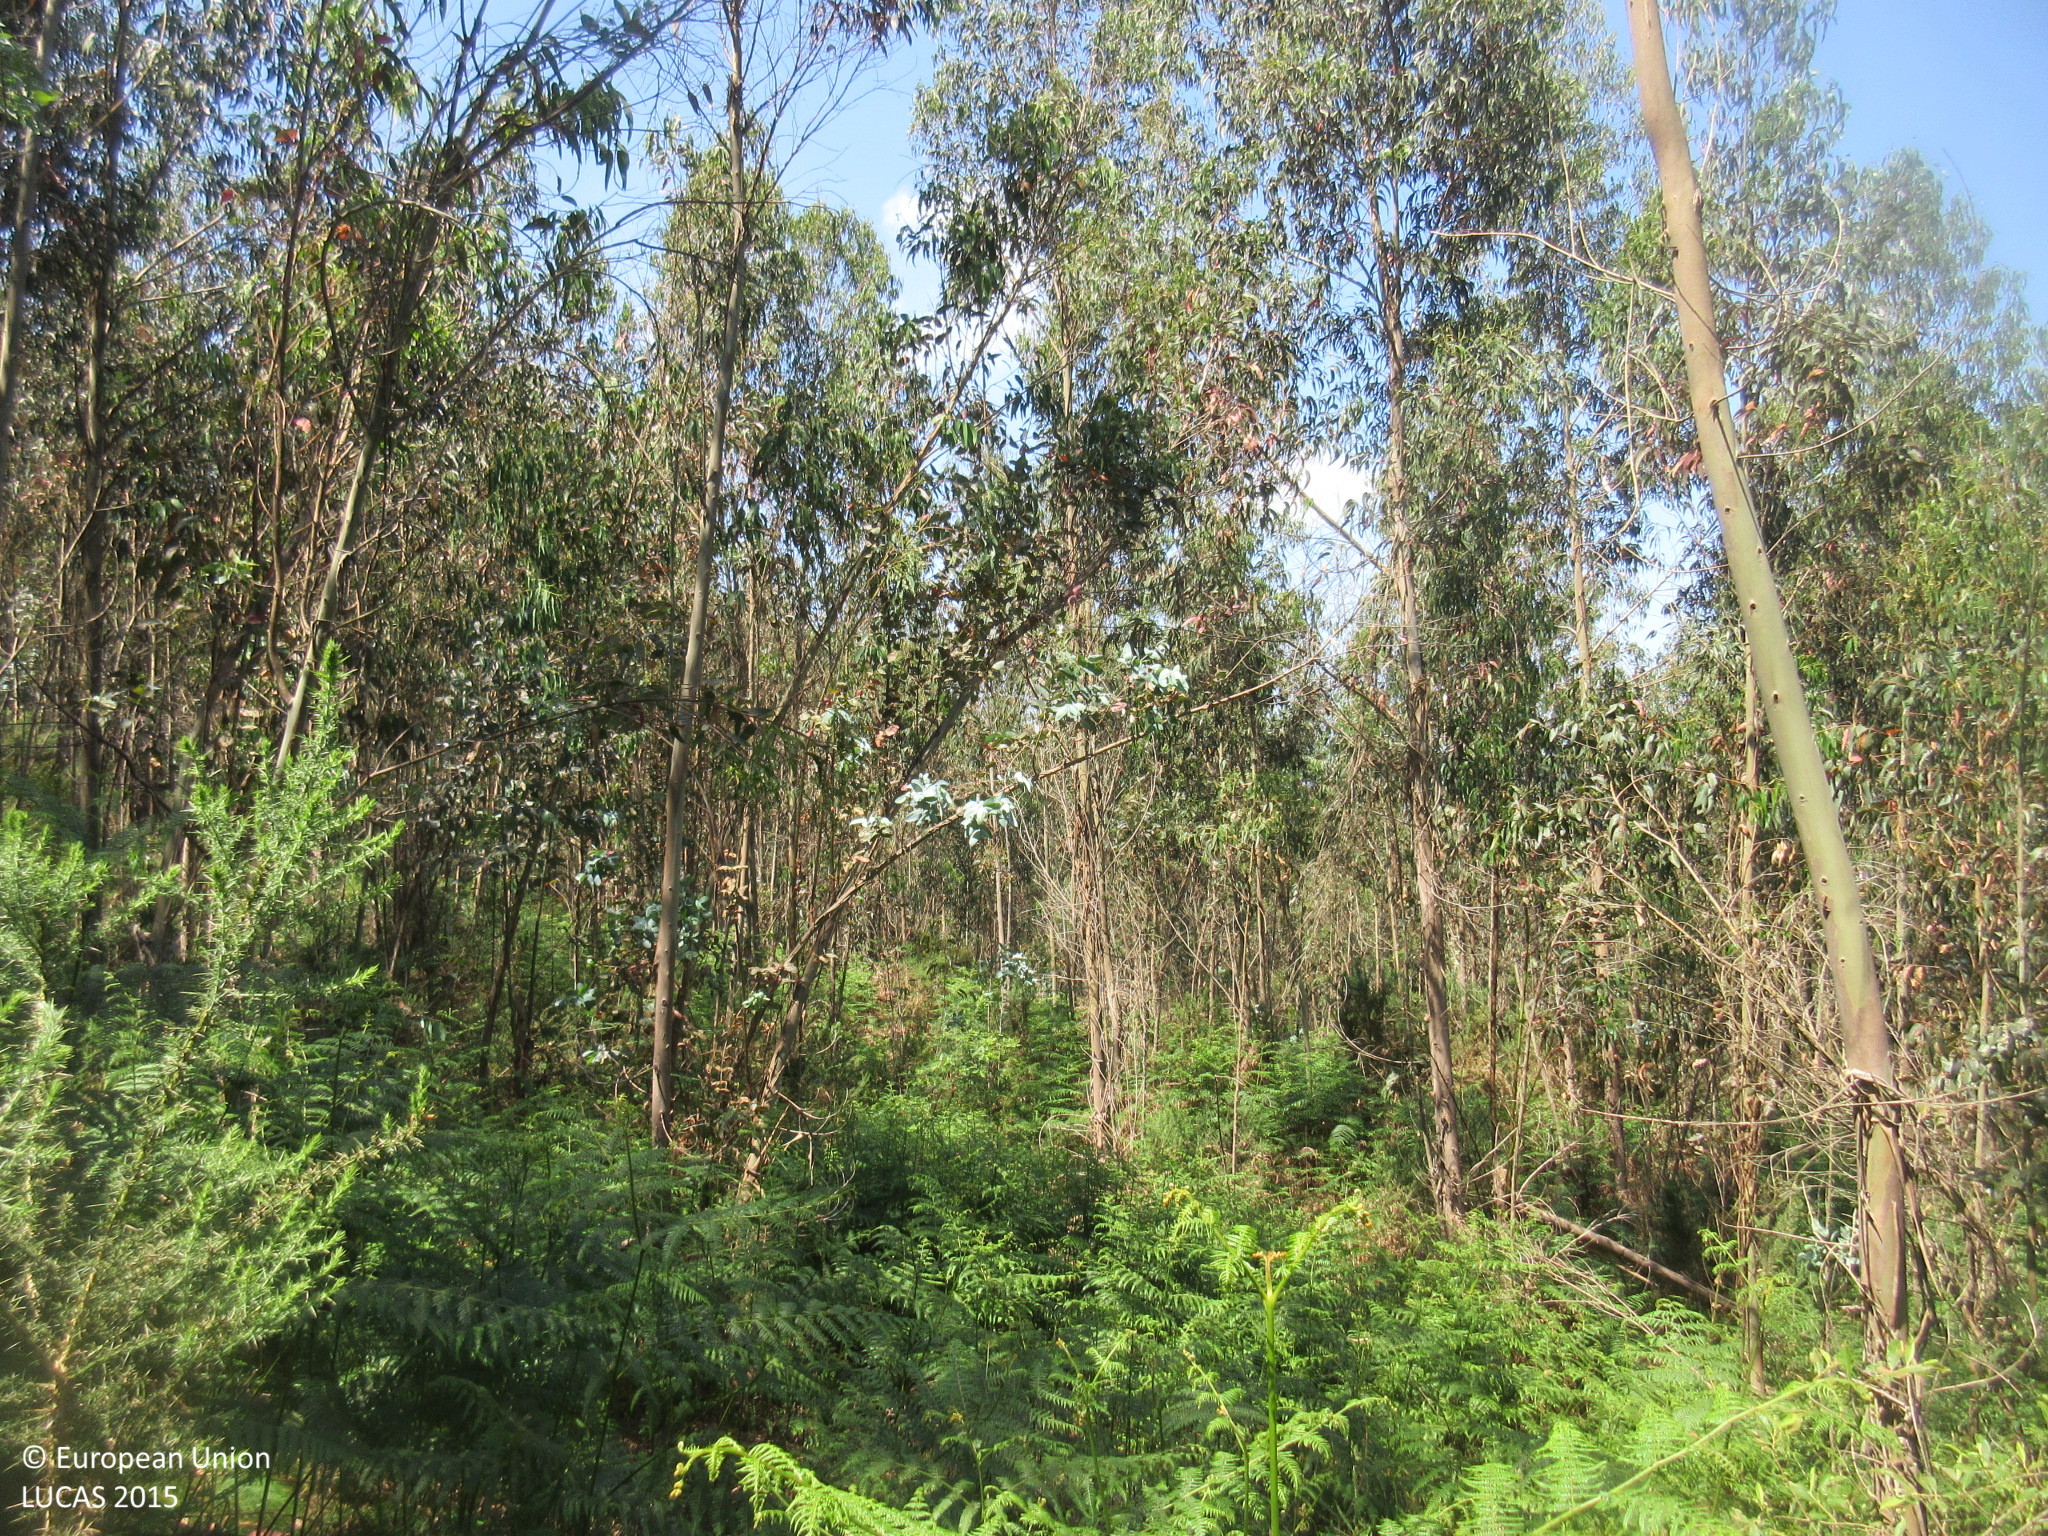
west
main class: Woodland
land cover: Broadleaved woodland
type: exotic forest
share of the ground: > 75 %
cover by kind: broadleaved forest trees 80 %, shrubs 20 %
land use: Forestry
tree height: > 5 m
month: June
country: ES
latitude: 43.4451
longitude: -6.0198
